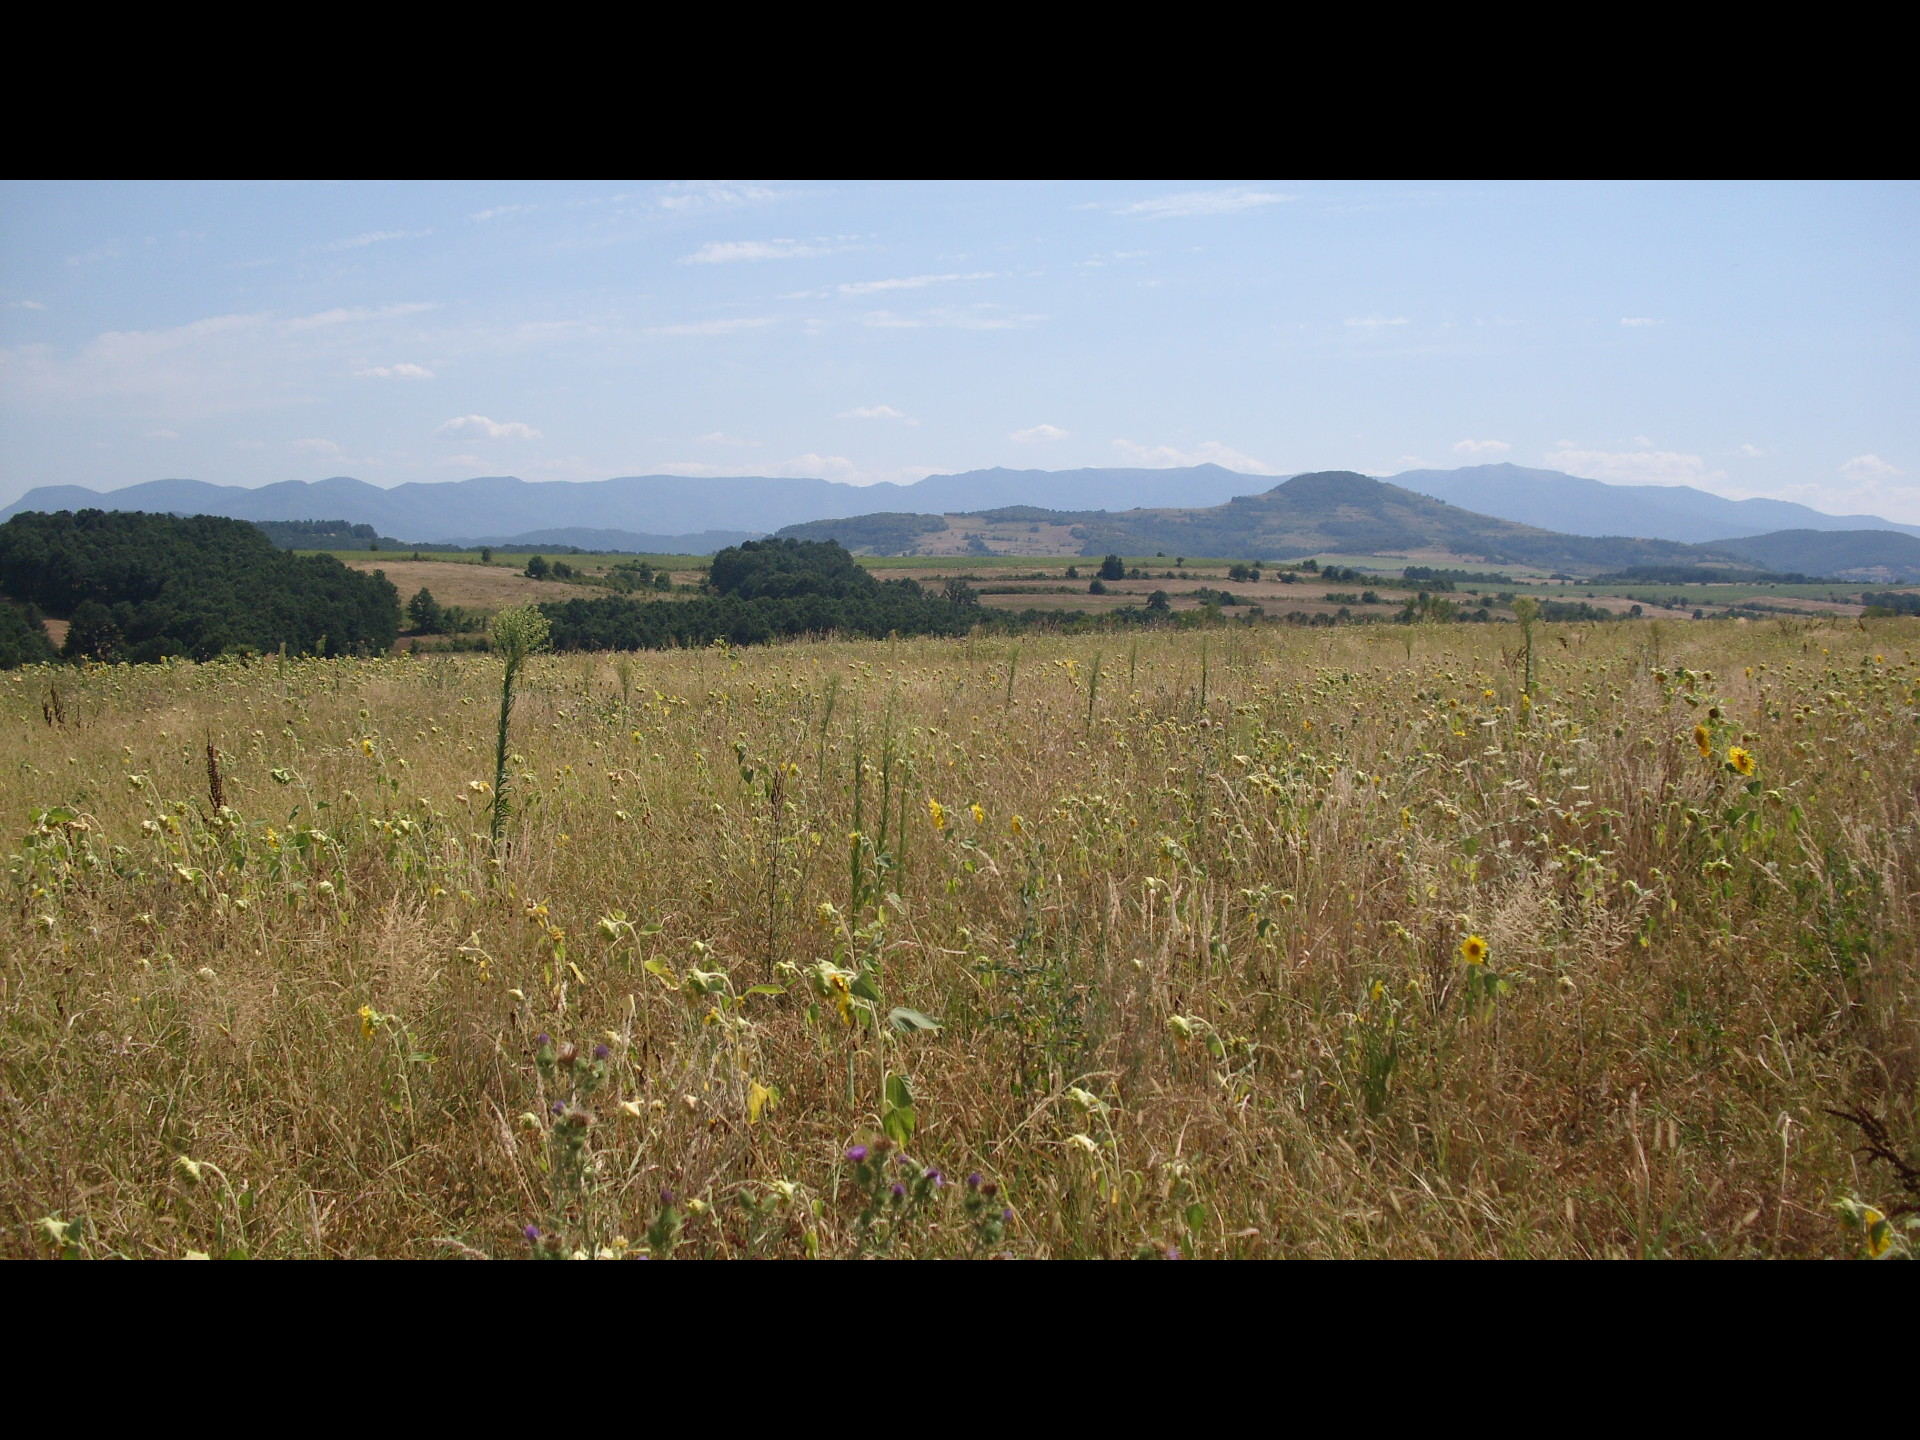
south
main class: Grassland
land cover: Spontaneously vegetated surfaces
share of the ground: > 75 %
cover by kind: herbaceous plants 100 %
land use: Agriculture (excluding fallow land and kitchen gardens)
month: August
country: BG
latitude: 43.3116
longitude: 23.2686
